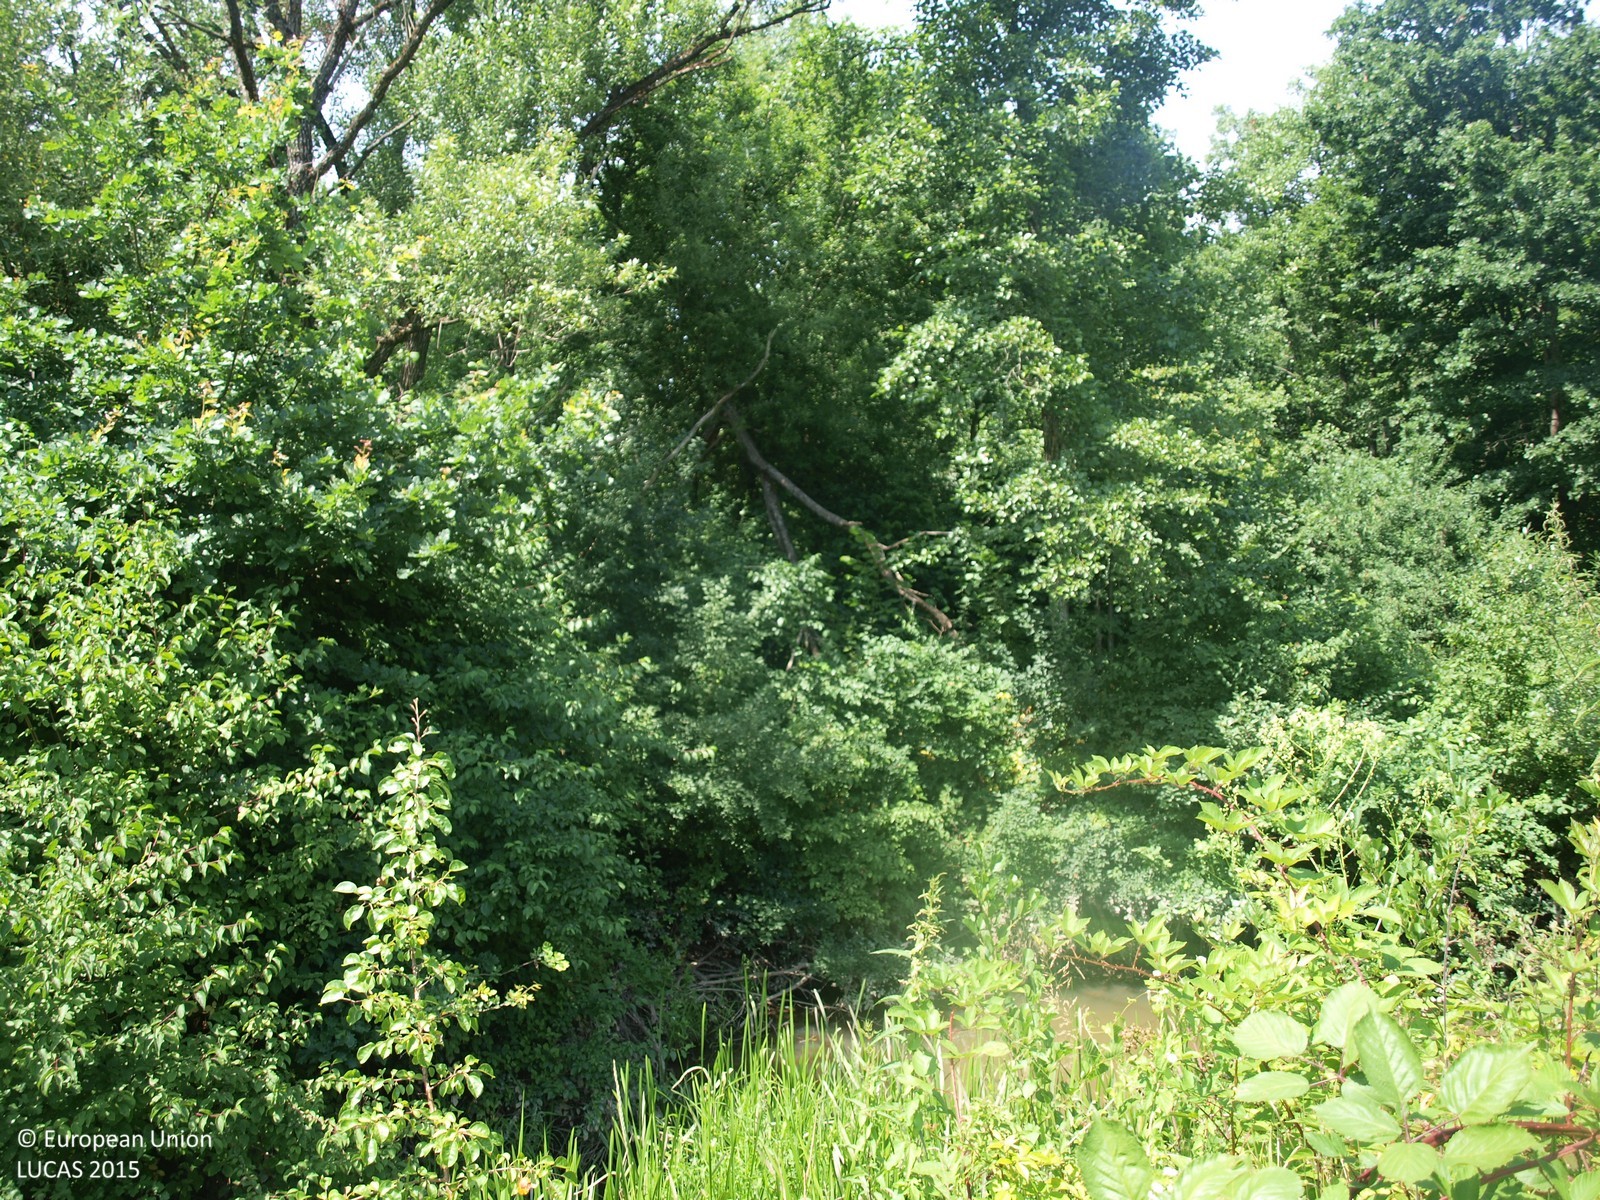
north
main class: Woodland
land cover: Broadleaved woodland
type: floodplain forest
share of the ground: > 75 %
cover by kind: broadleaved forest trees 100 %
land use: Forestry
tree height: > 5 m
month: July
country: HR
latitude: 45.6377
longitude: 15.7315
